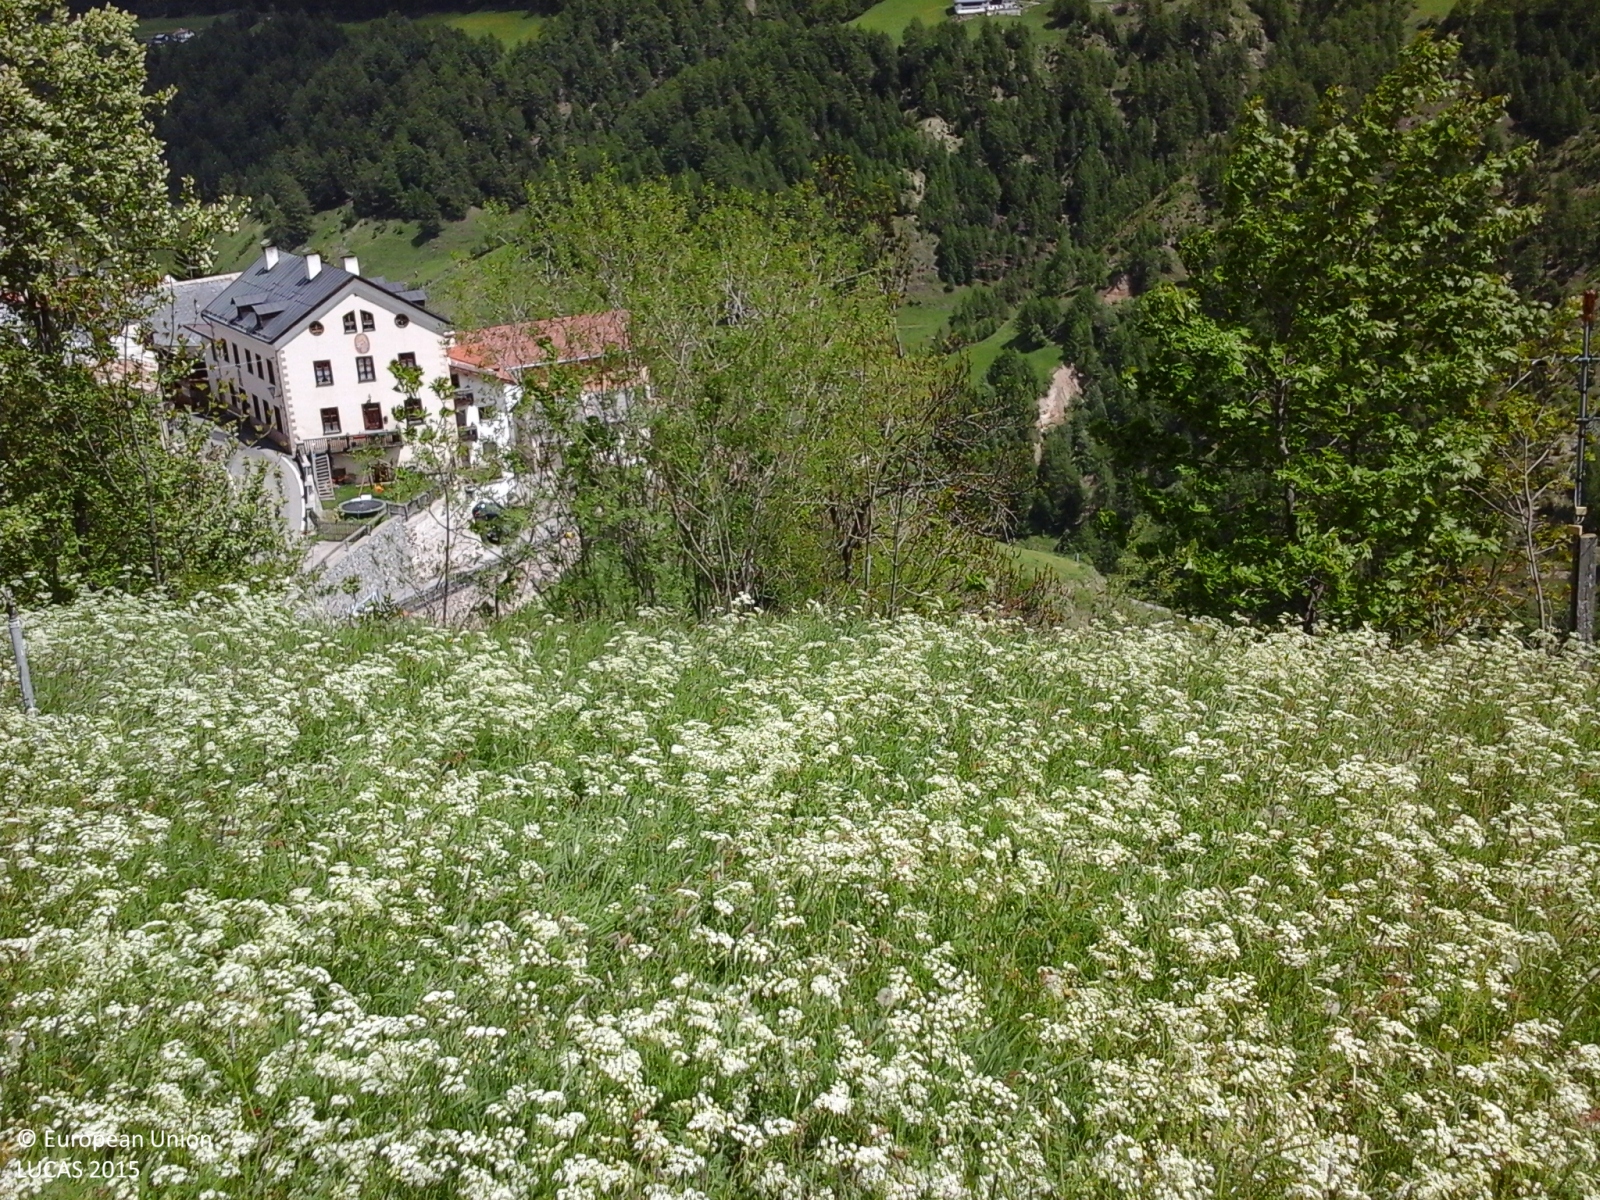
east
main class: Grassland
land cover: Grassland without tree/shrub cover
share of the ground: > 75 %
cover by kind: herbaceous plants 100 %
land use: Agriculture (excluding fallow land and kitchen gardens)
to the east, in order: Grassland without tree/shrub cover; Managed hedges; Shrubland with sparse tree cover; Paved roads, cycling and walking lanes; Artificial constructions; Shrubland with sparse tree cover; Rivers and streams; Fences; Managed hedges; Fences; Grassland without tree/shrub cover; Fences; Grassland without tree/shrub cover
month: May
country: IT
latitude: 46.6917
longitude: 10.6138
